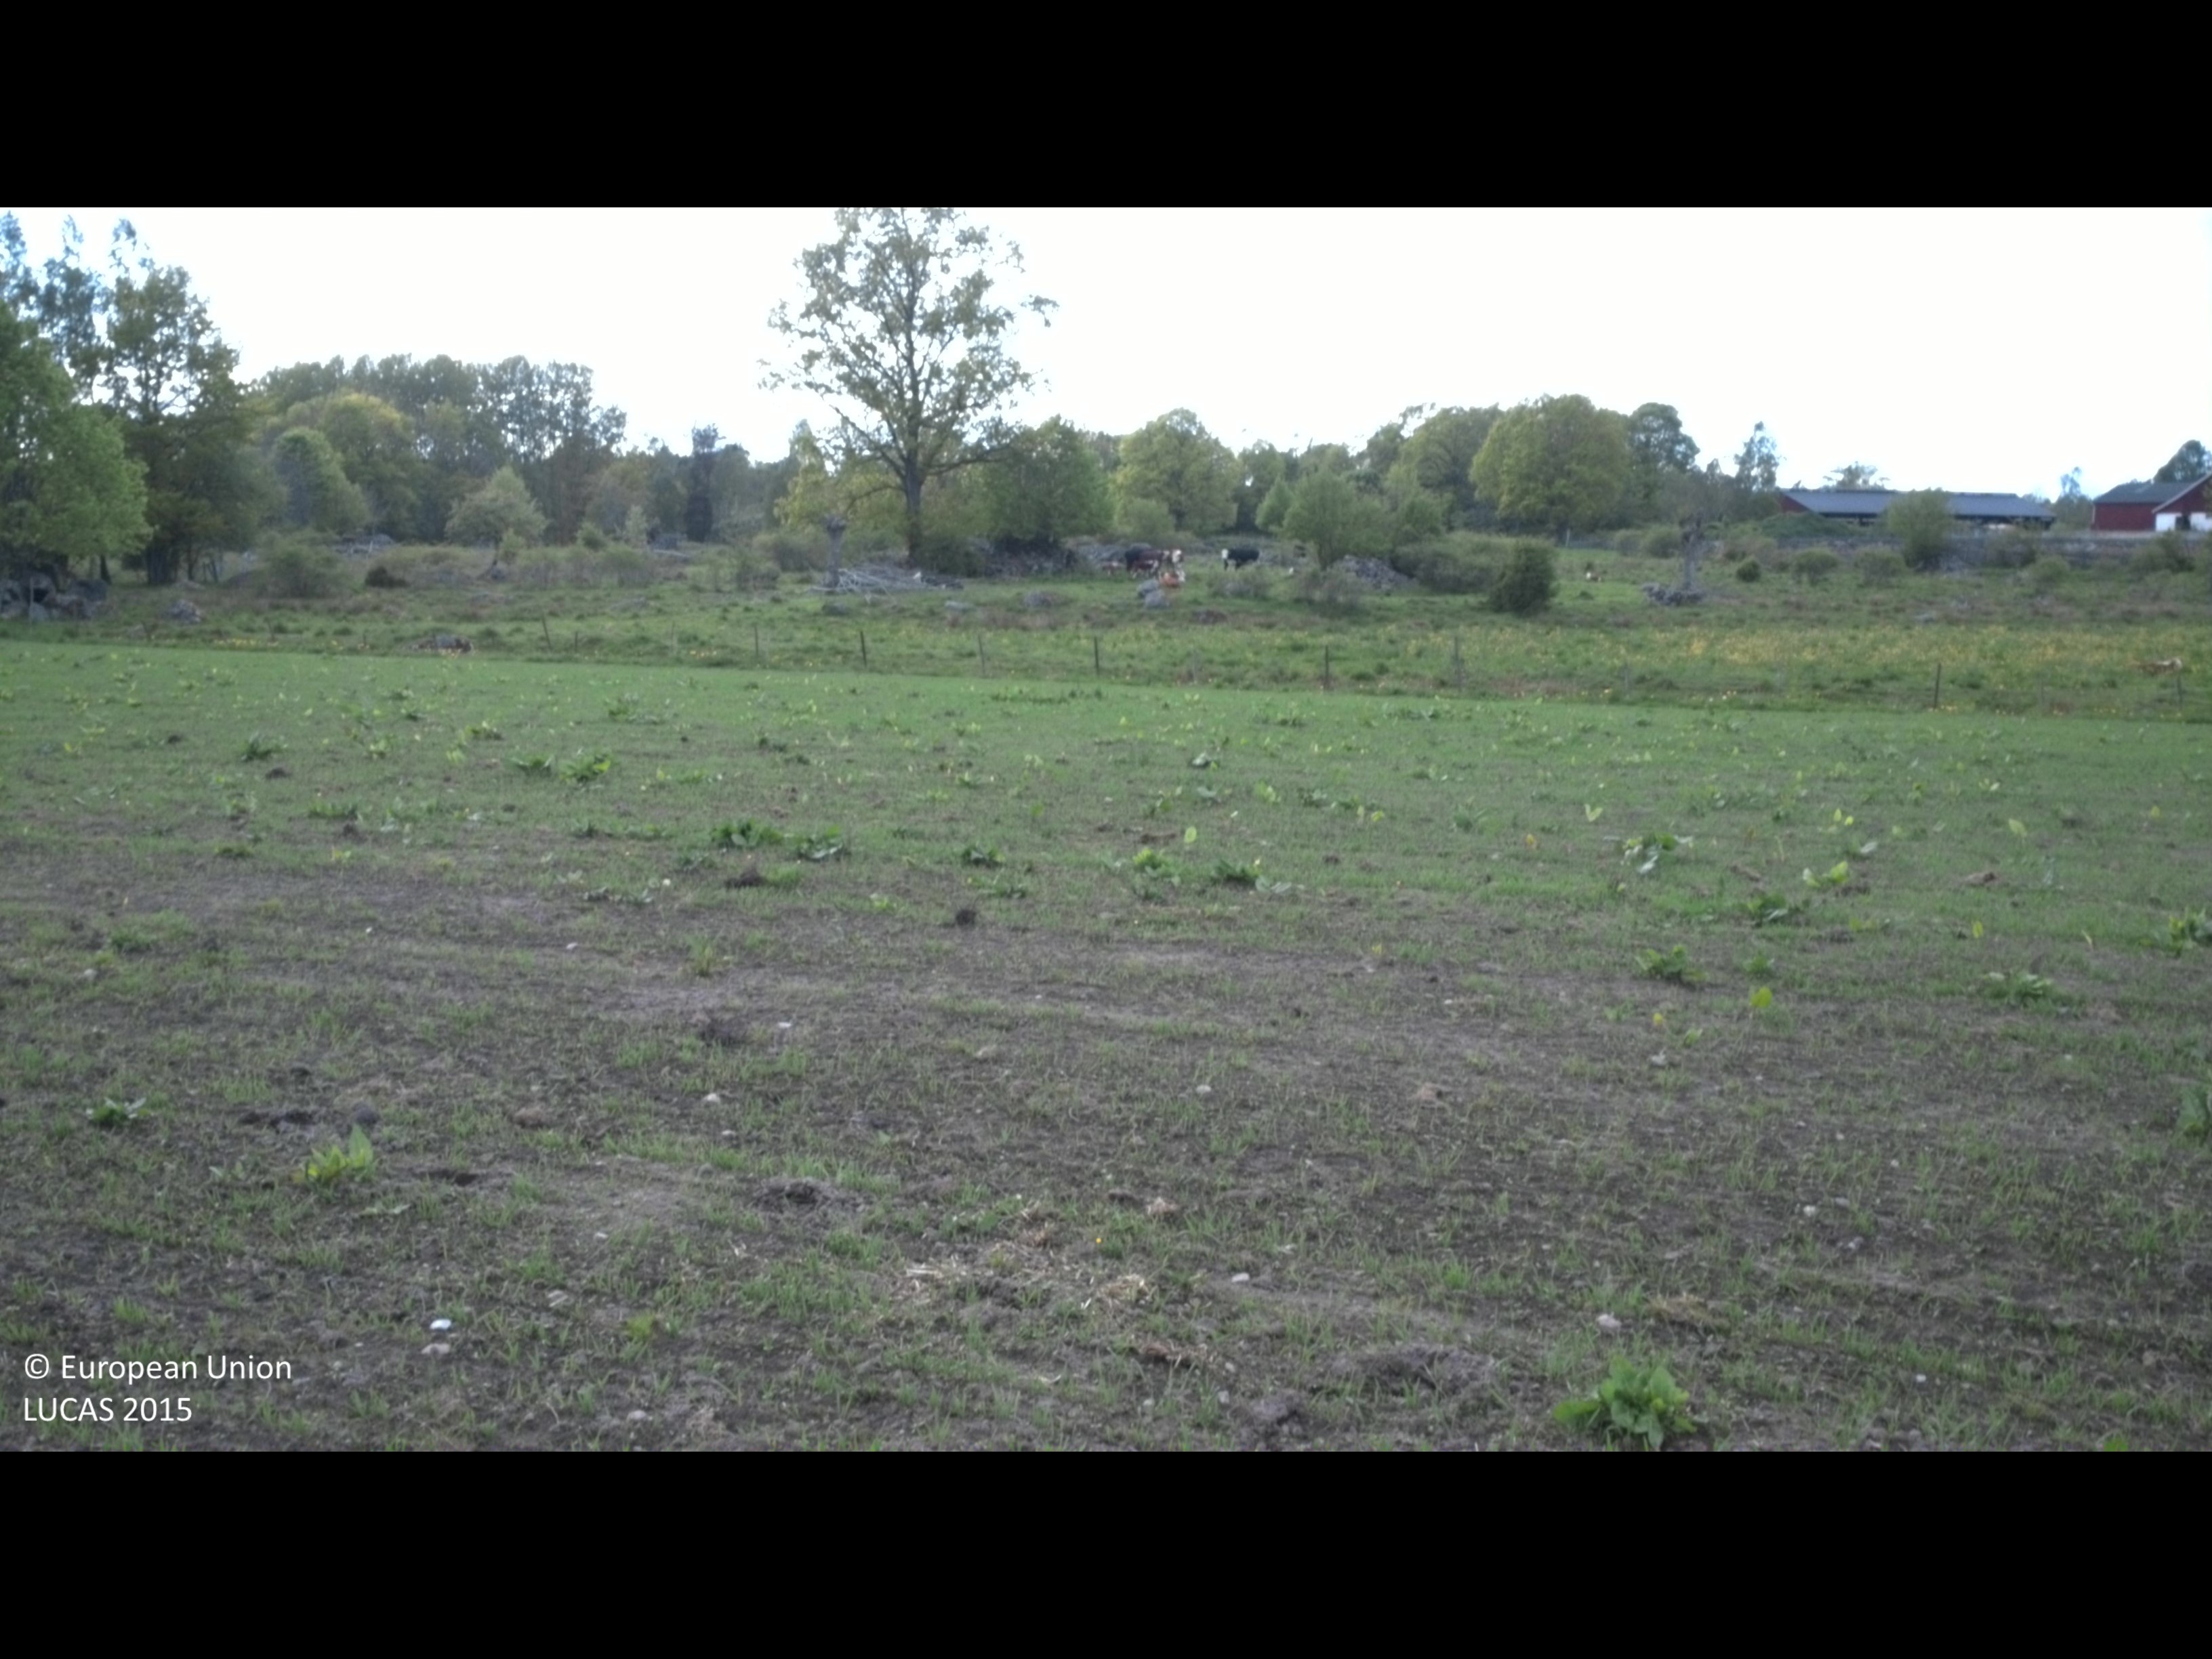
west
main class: Cropland
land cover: Temporary grasslands
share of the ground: < 10 %
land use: Agriculture (excluding fallow land and kitchen gardens)
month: May
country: SE
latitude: 57.3385
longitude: 16.1624
